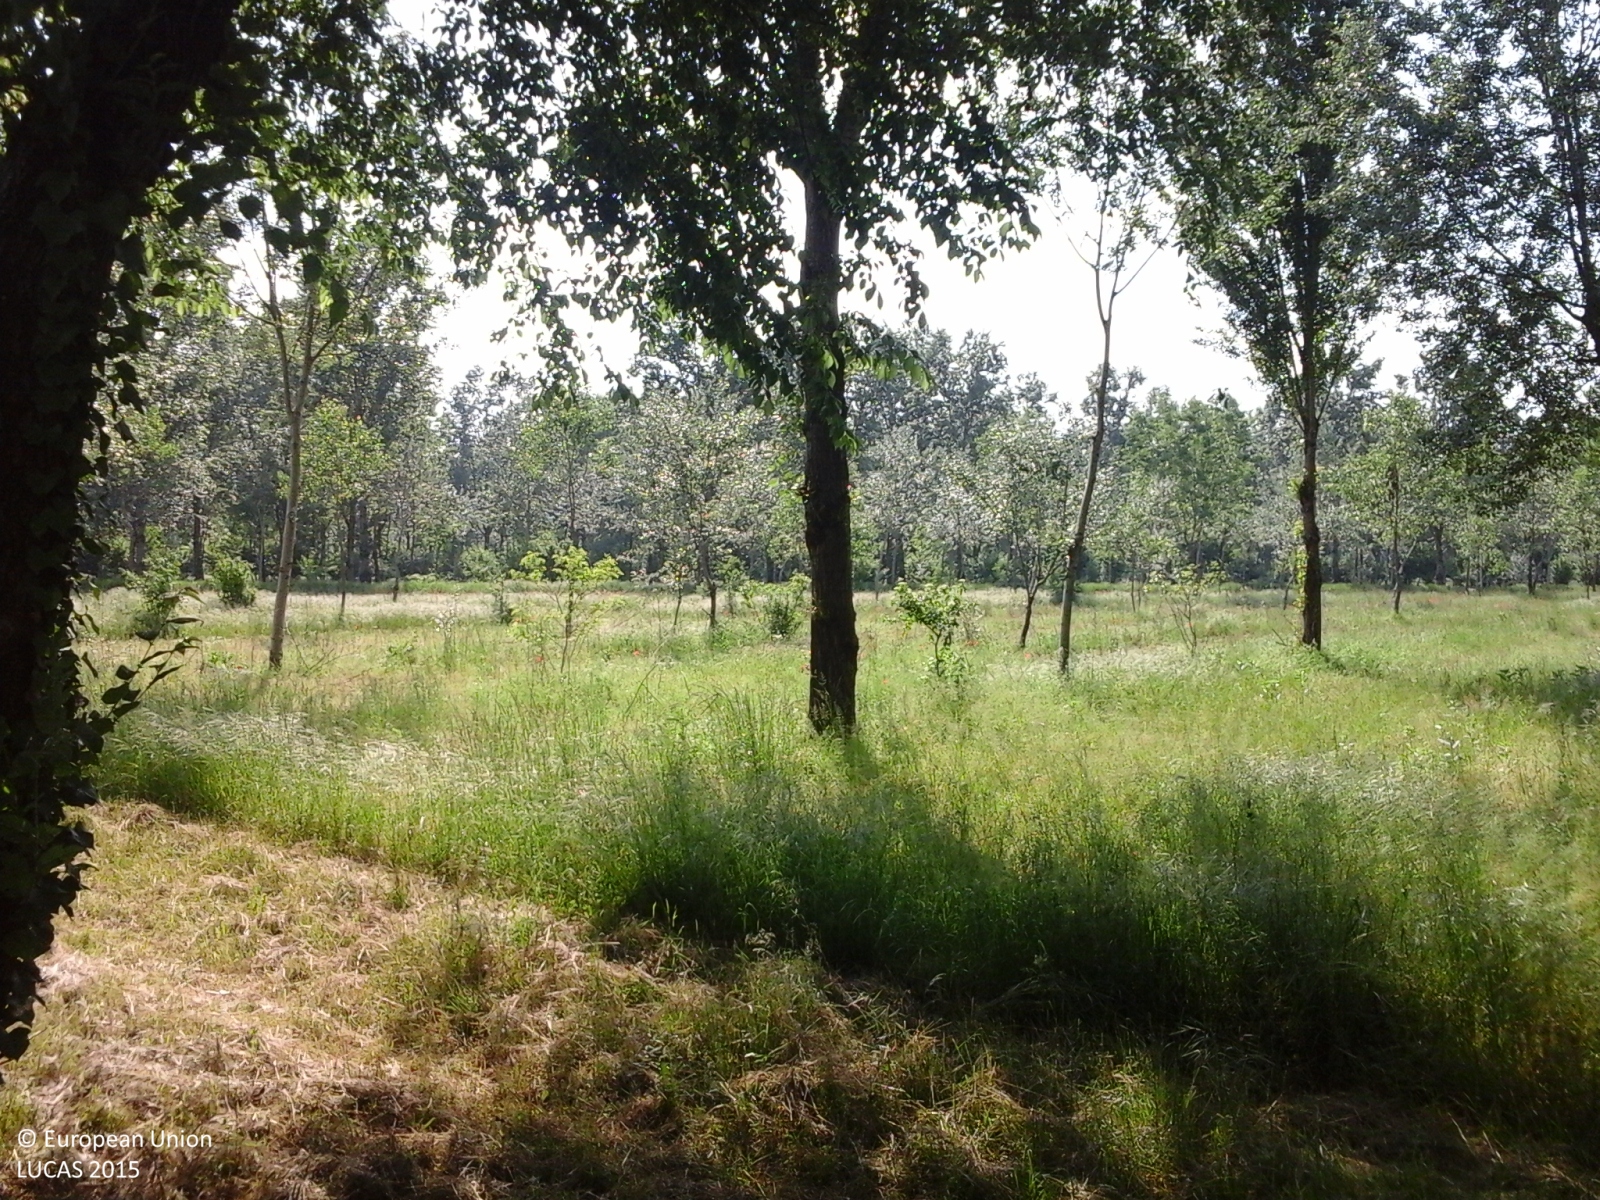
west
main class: Woodland
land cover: Broadleaved woodland
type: floodplain forest
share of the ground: 25 - 50 %
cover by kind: broadleaved forest trees 50 %, herbaceous plants 50 %
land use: Forestry
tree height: > 5 m
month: May
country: IT
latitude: 45.2122
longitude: 9.0976
